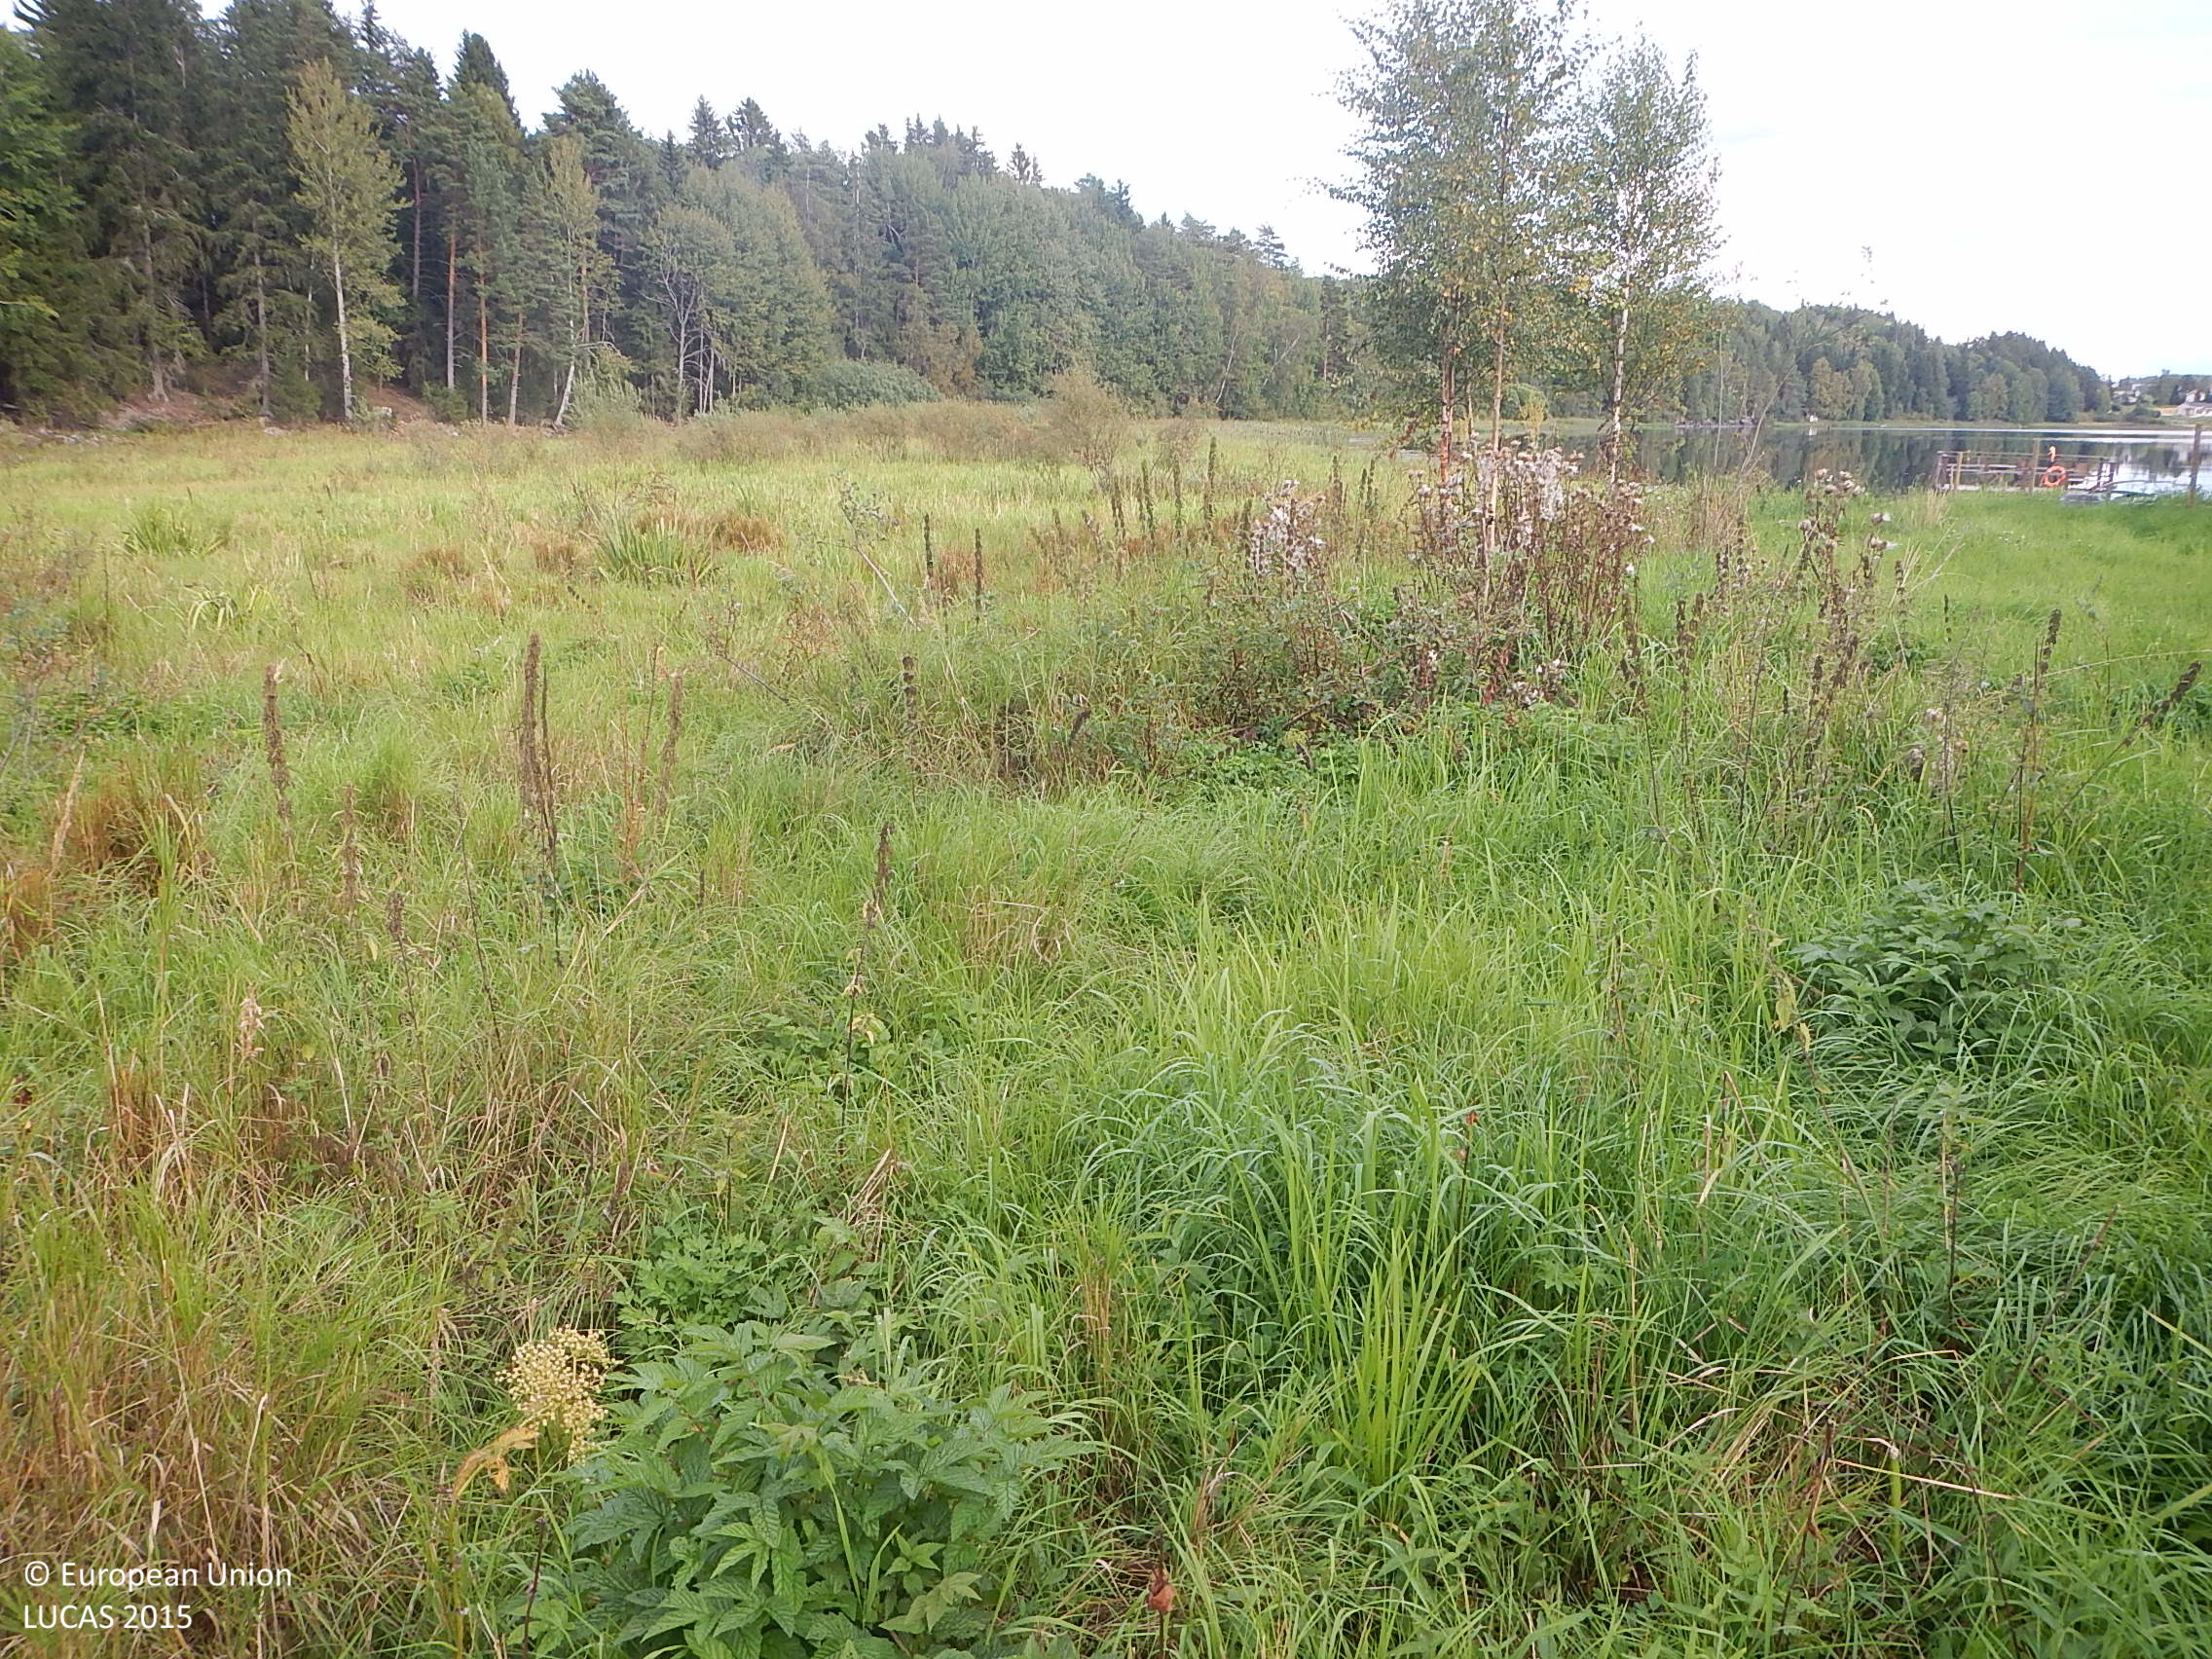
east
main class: Grassland
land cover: Grassland without tree/shrub cover
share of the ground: > 75 %
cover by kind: herbaceous plants 100 %
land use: Agriculture (excluding fallow land and kitchen gardens)
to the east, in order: Grassland without tree/shrub cover; Spontaneously vegetated surfaces; Inland marshes; Inland fresh water bodies; Inland marshes; Fences; Broadleaved woodland; Spruce dominated mixed woodland
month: September
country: FI
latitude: 61.5162
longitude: 22.9838
